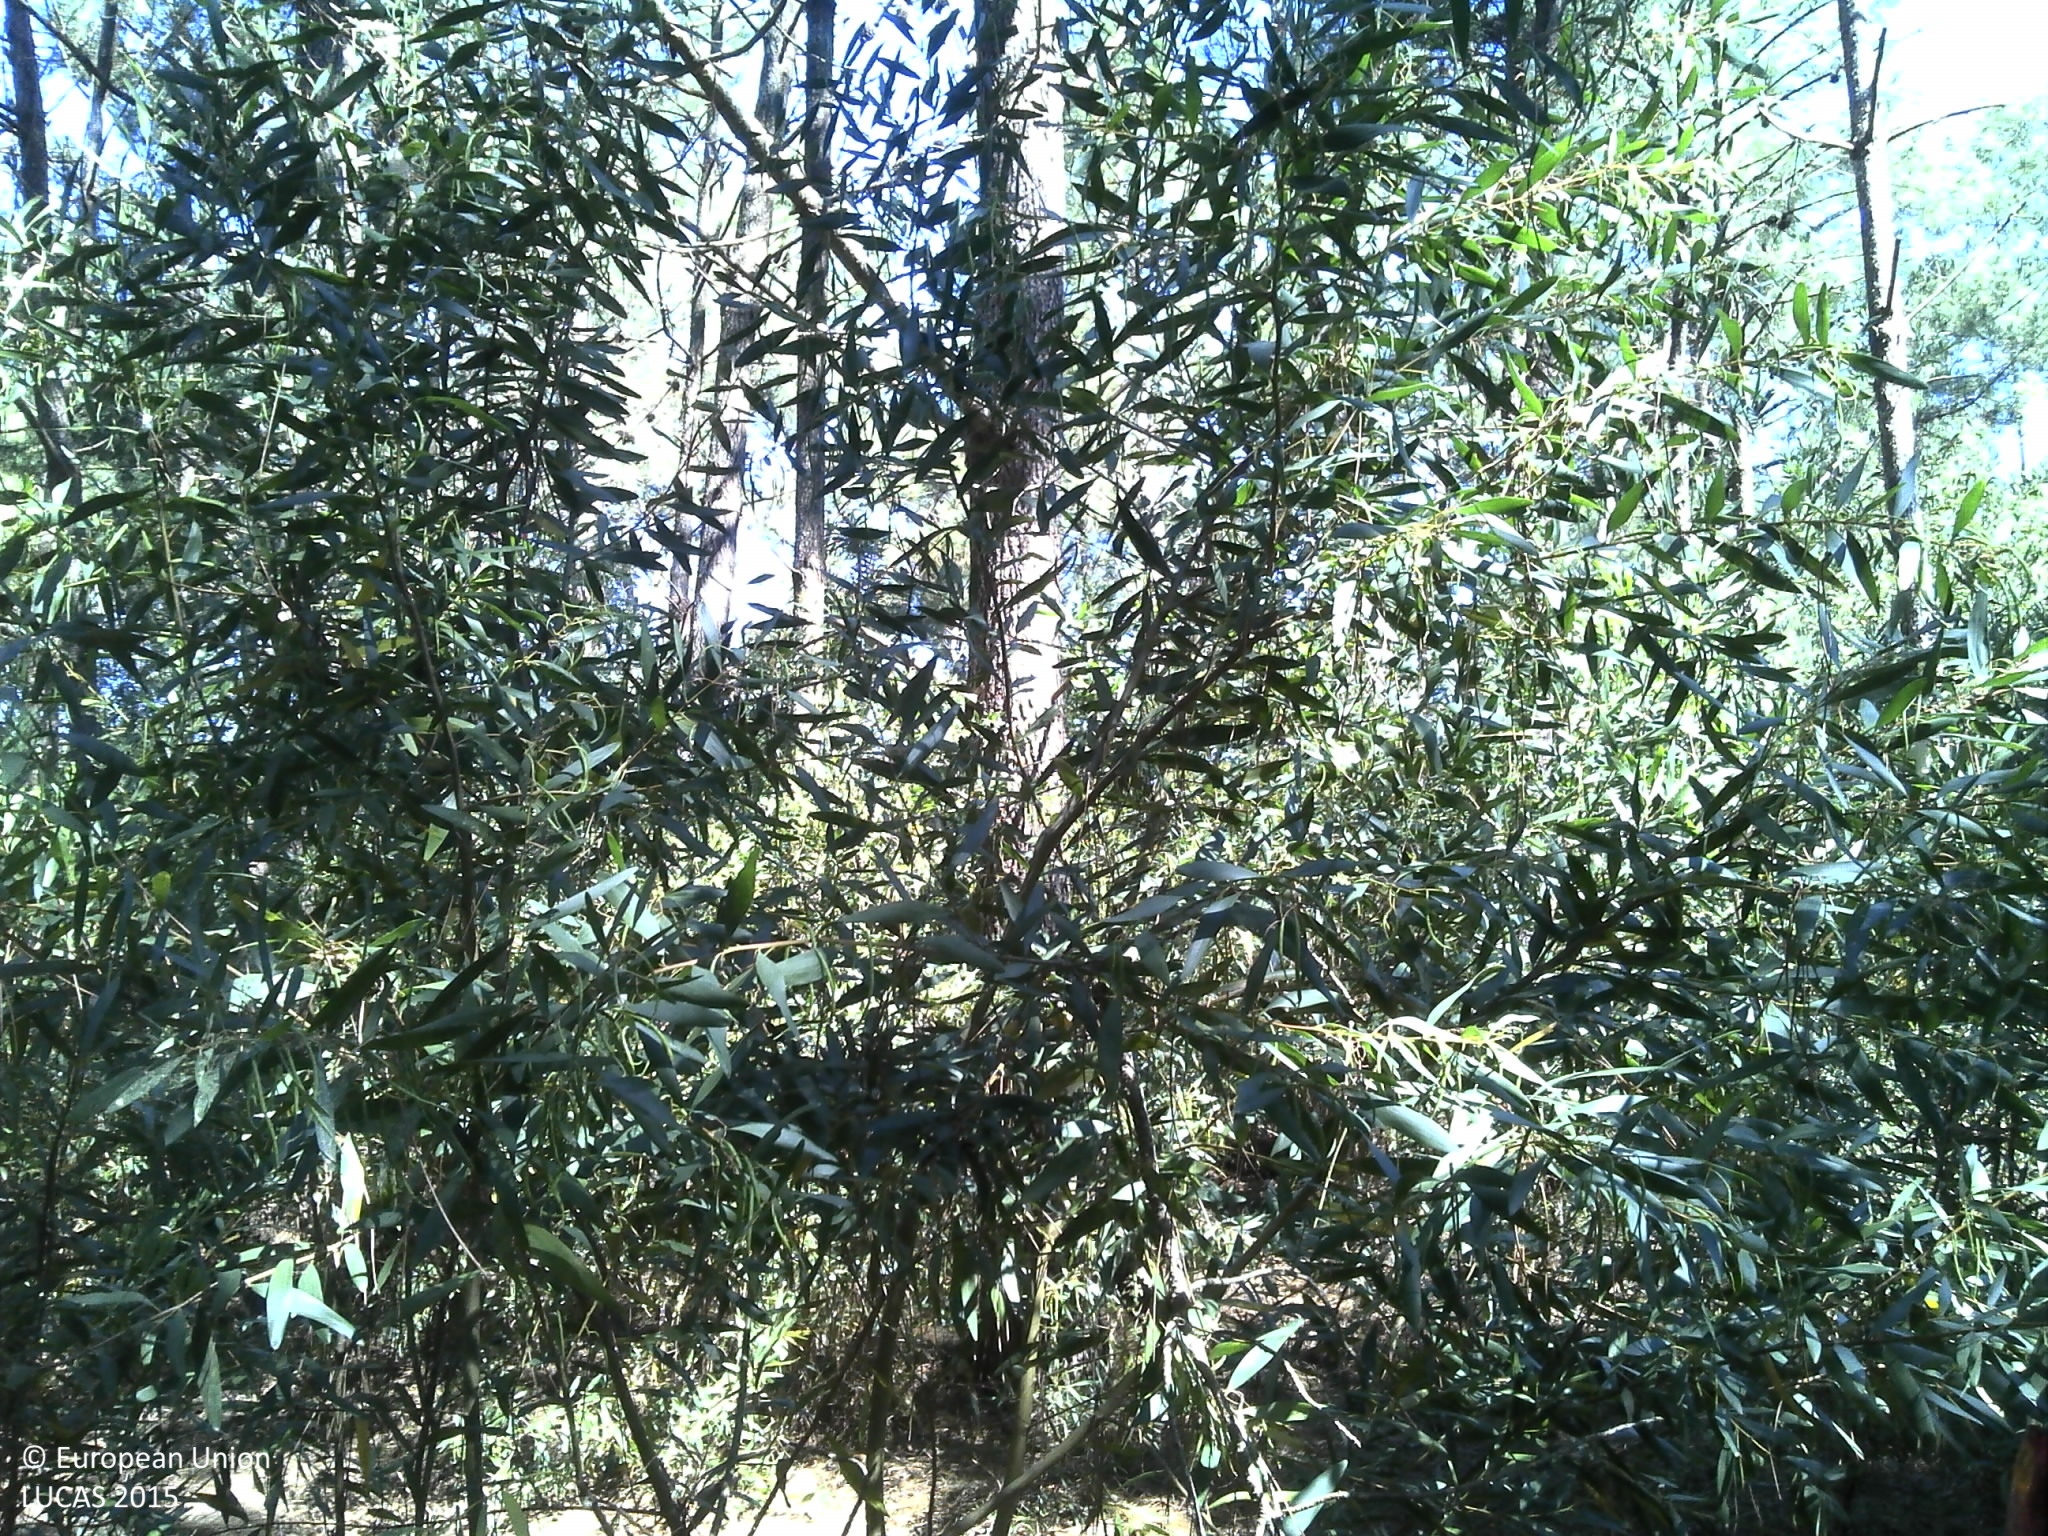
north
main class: Woodland
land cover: Pine dominated coniferous woodland
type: coniferous forest of the mediterranean region
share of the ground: 50 - 75 %
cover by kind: coniferous forest trees 65 %, shrubs 20 %, unconsolidated bare surface 15 %
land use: Forestry
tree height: > 5 m
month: May
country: PT
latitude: 40.5129
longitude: -8.7574
